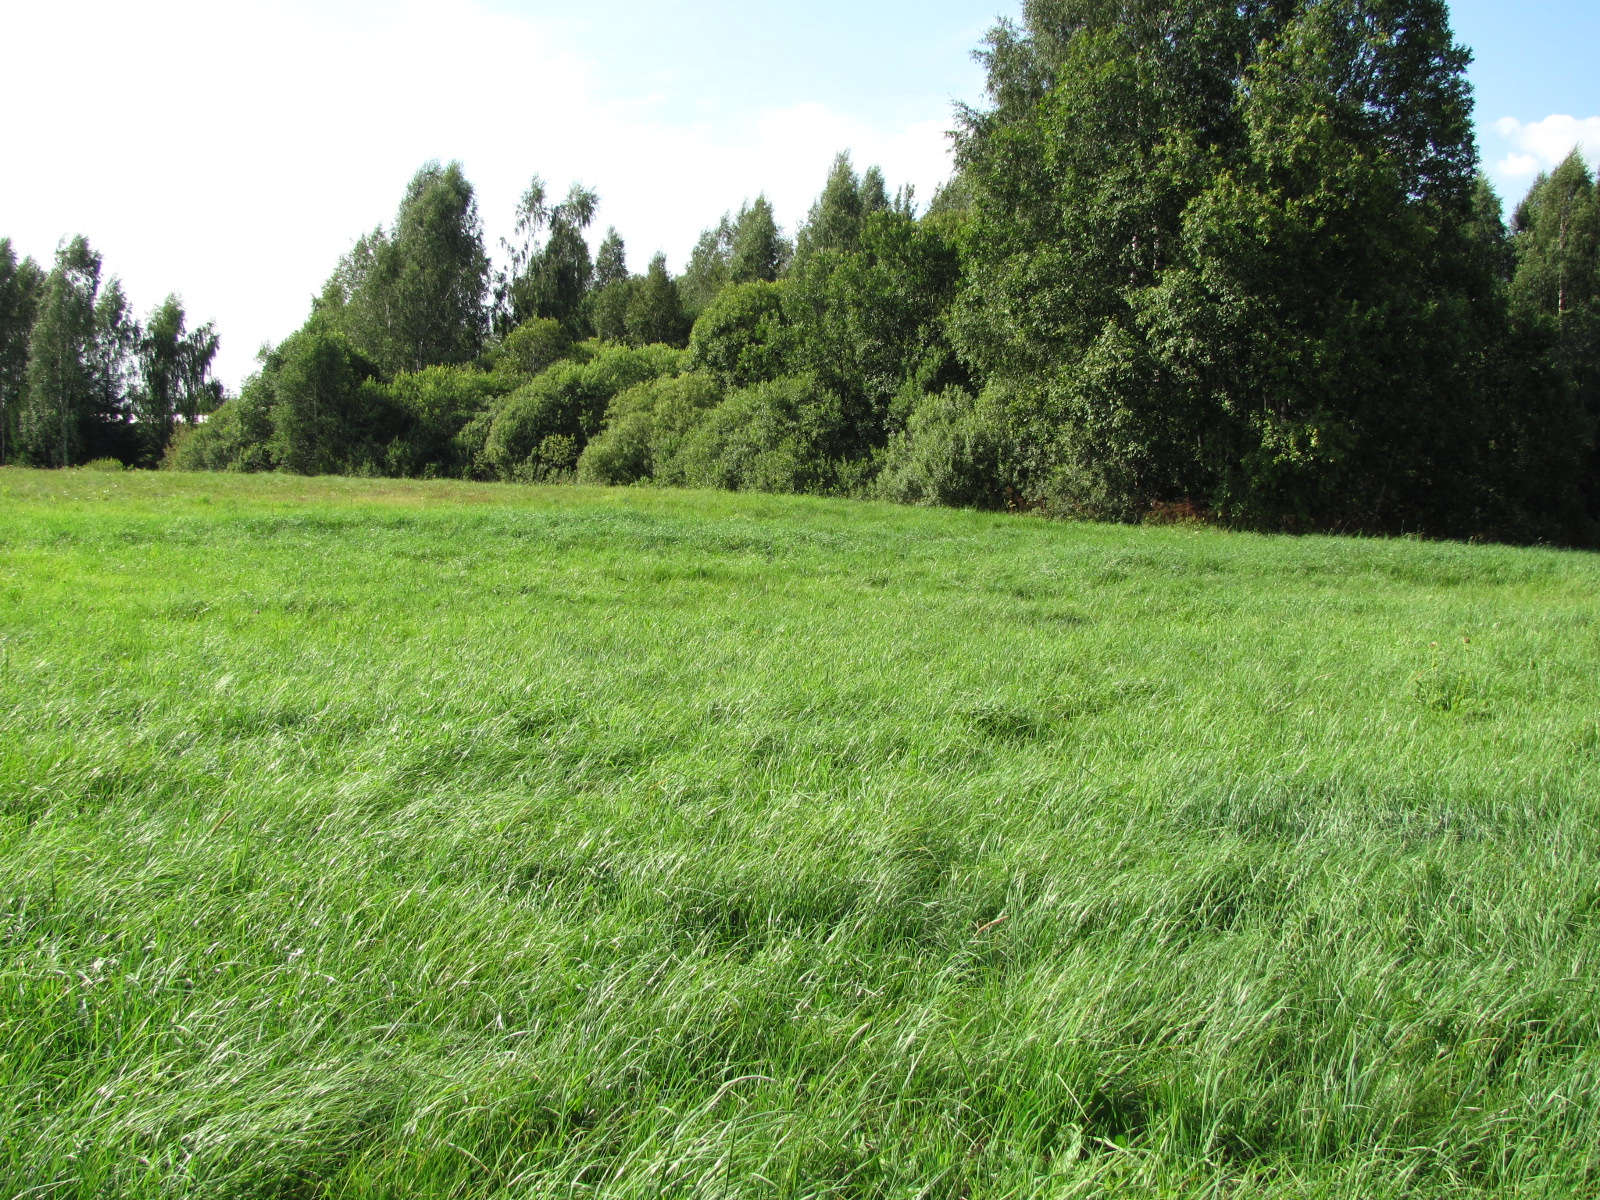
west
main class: Grassland
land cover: Grassland without tree/shrub cover
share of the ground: > 75 %
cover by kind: herbaceous plants 100 %
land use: Agriculture (excluding fallow land and kitchen gardens)
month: August
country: LV
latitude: 56.9904
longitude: 25.2702
